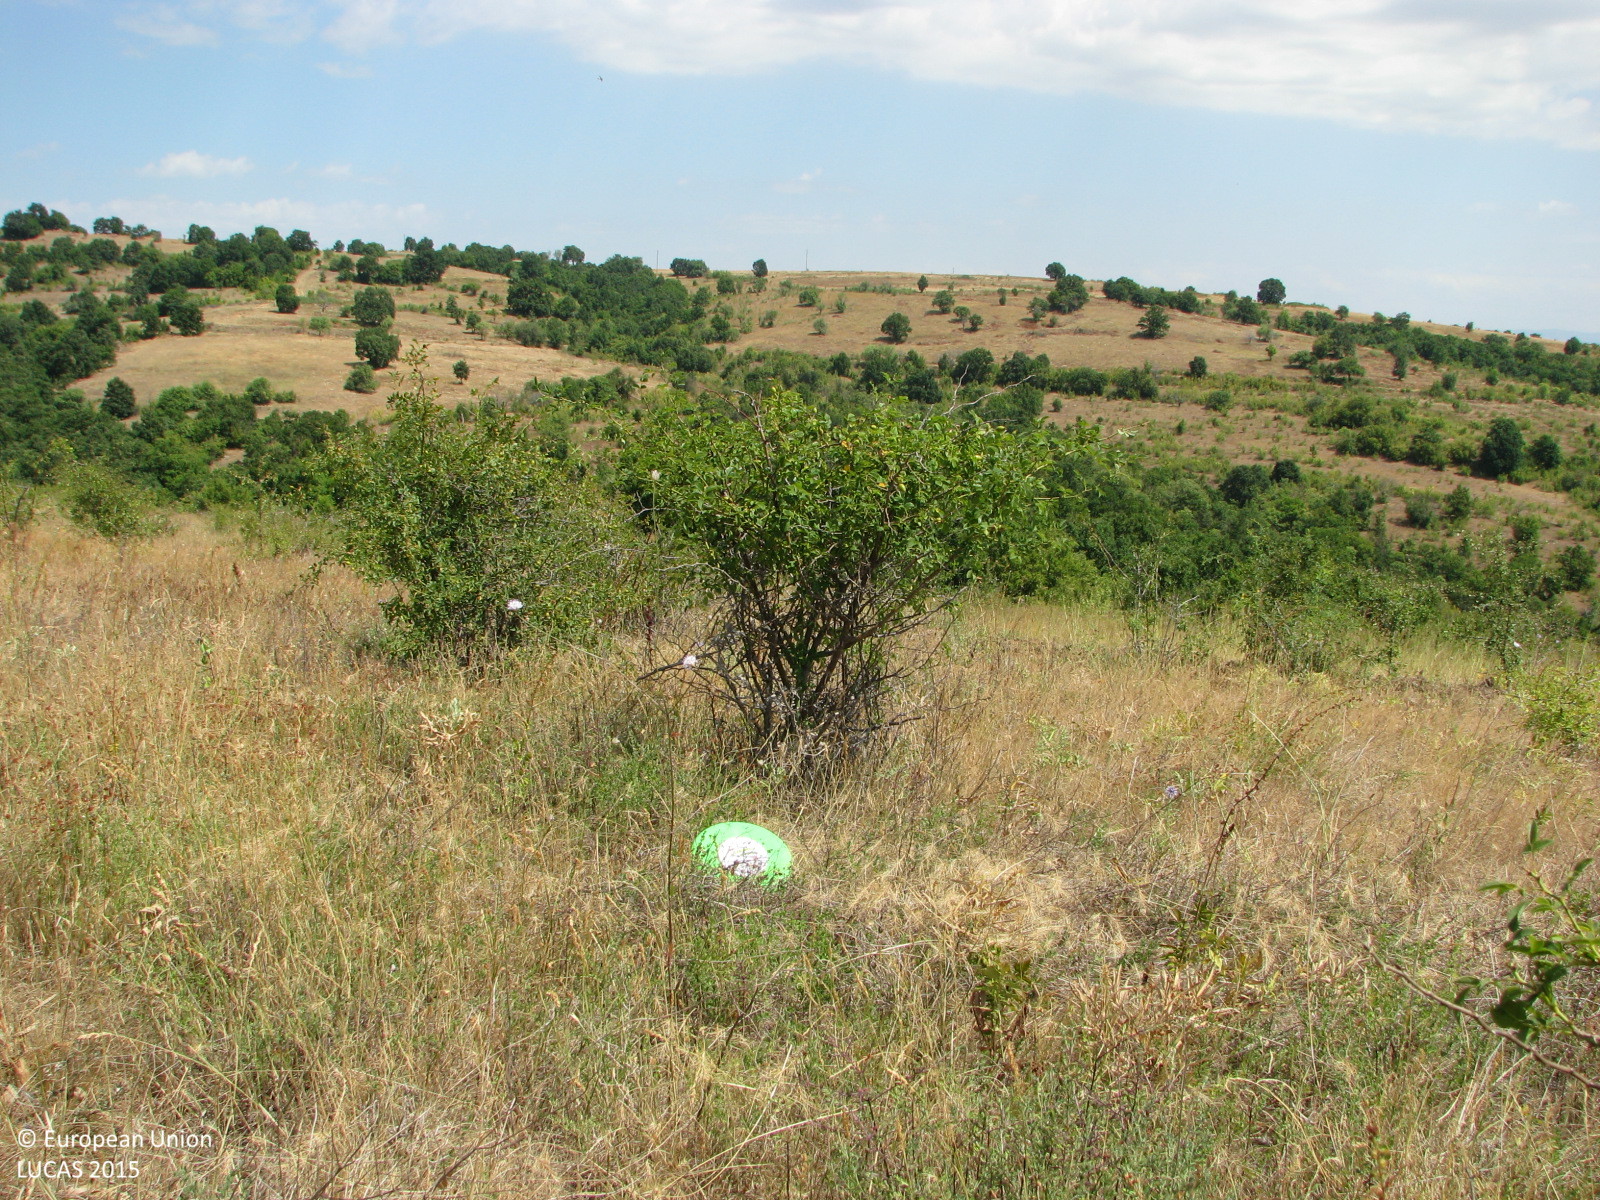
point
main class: Shrubland
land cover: Shrubland without tree cover
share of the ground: 10 - 25 %
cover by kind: herbaceous plants 80 %, shrubs 20 %
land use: Agriculture (excluding fallow land and kitchen gardens)
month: August
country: BG
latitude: 42.6877
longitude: 26.6109
